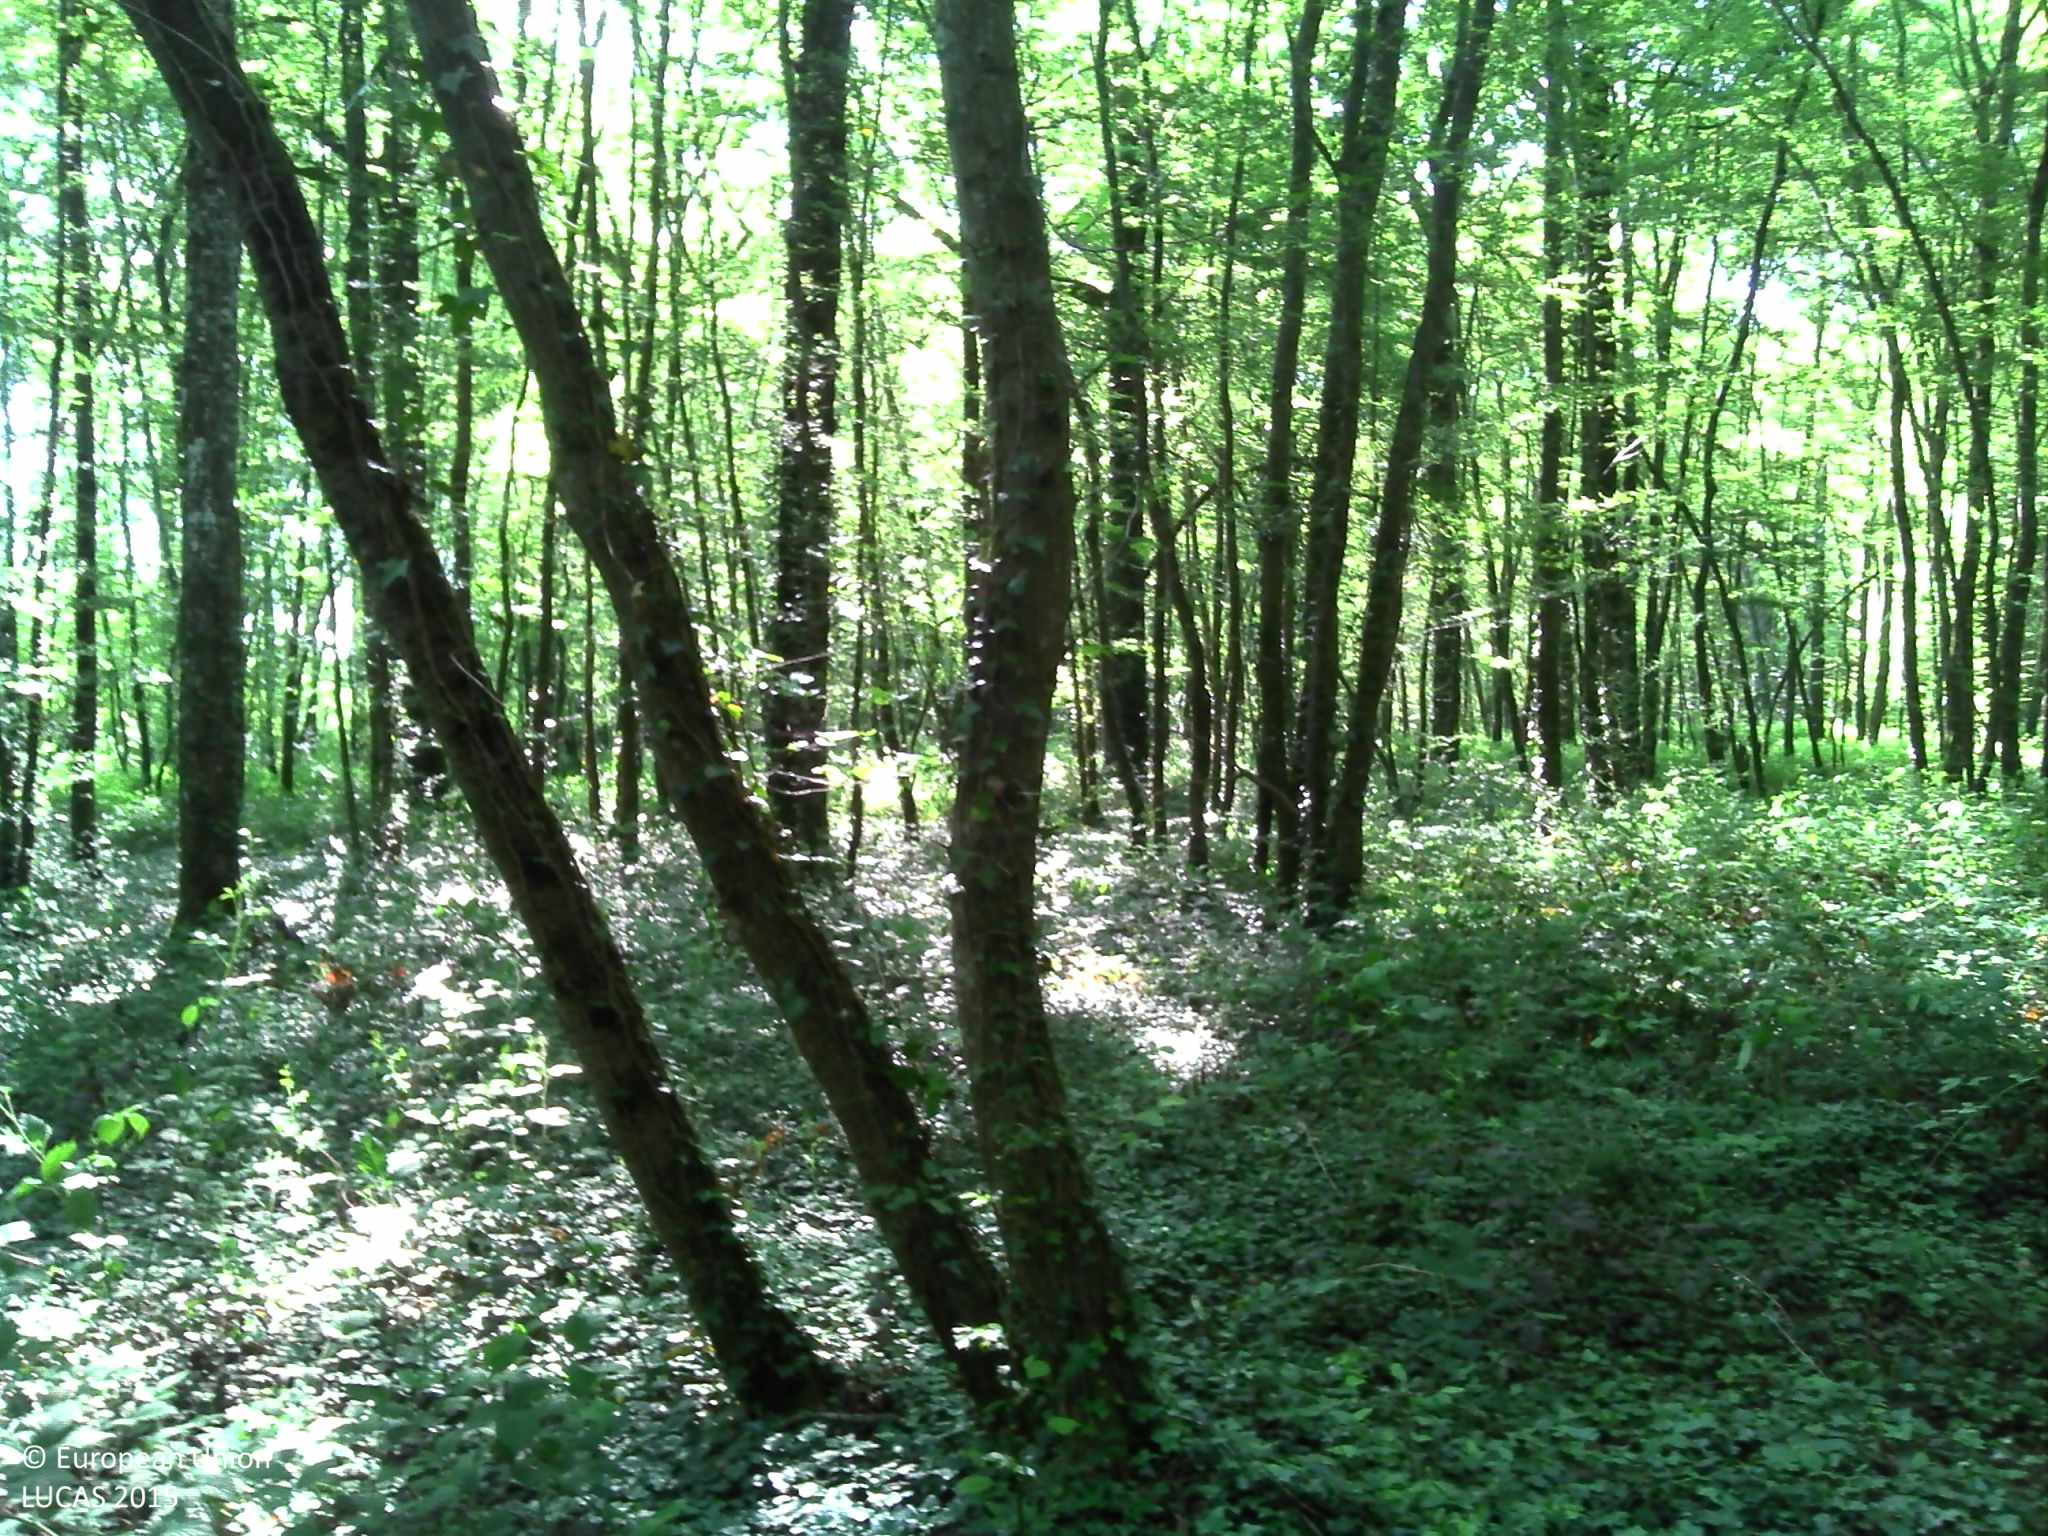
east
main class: Woodland
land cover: Broadleaved woodland
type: mesophytic deciduous forest
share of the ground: > 75 %
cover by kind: broadleaved forest trees 100 %
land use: Forestry
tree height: > 5 m
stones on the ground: < 10 %
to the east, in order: Broadleaved woodland; Tracks; Broadleaved woodland
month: June
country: FR
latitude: 47.0911
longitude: 2.6298
